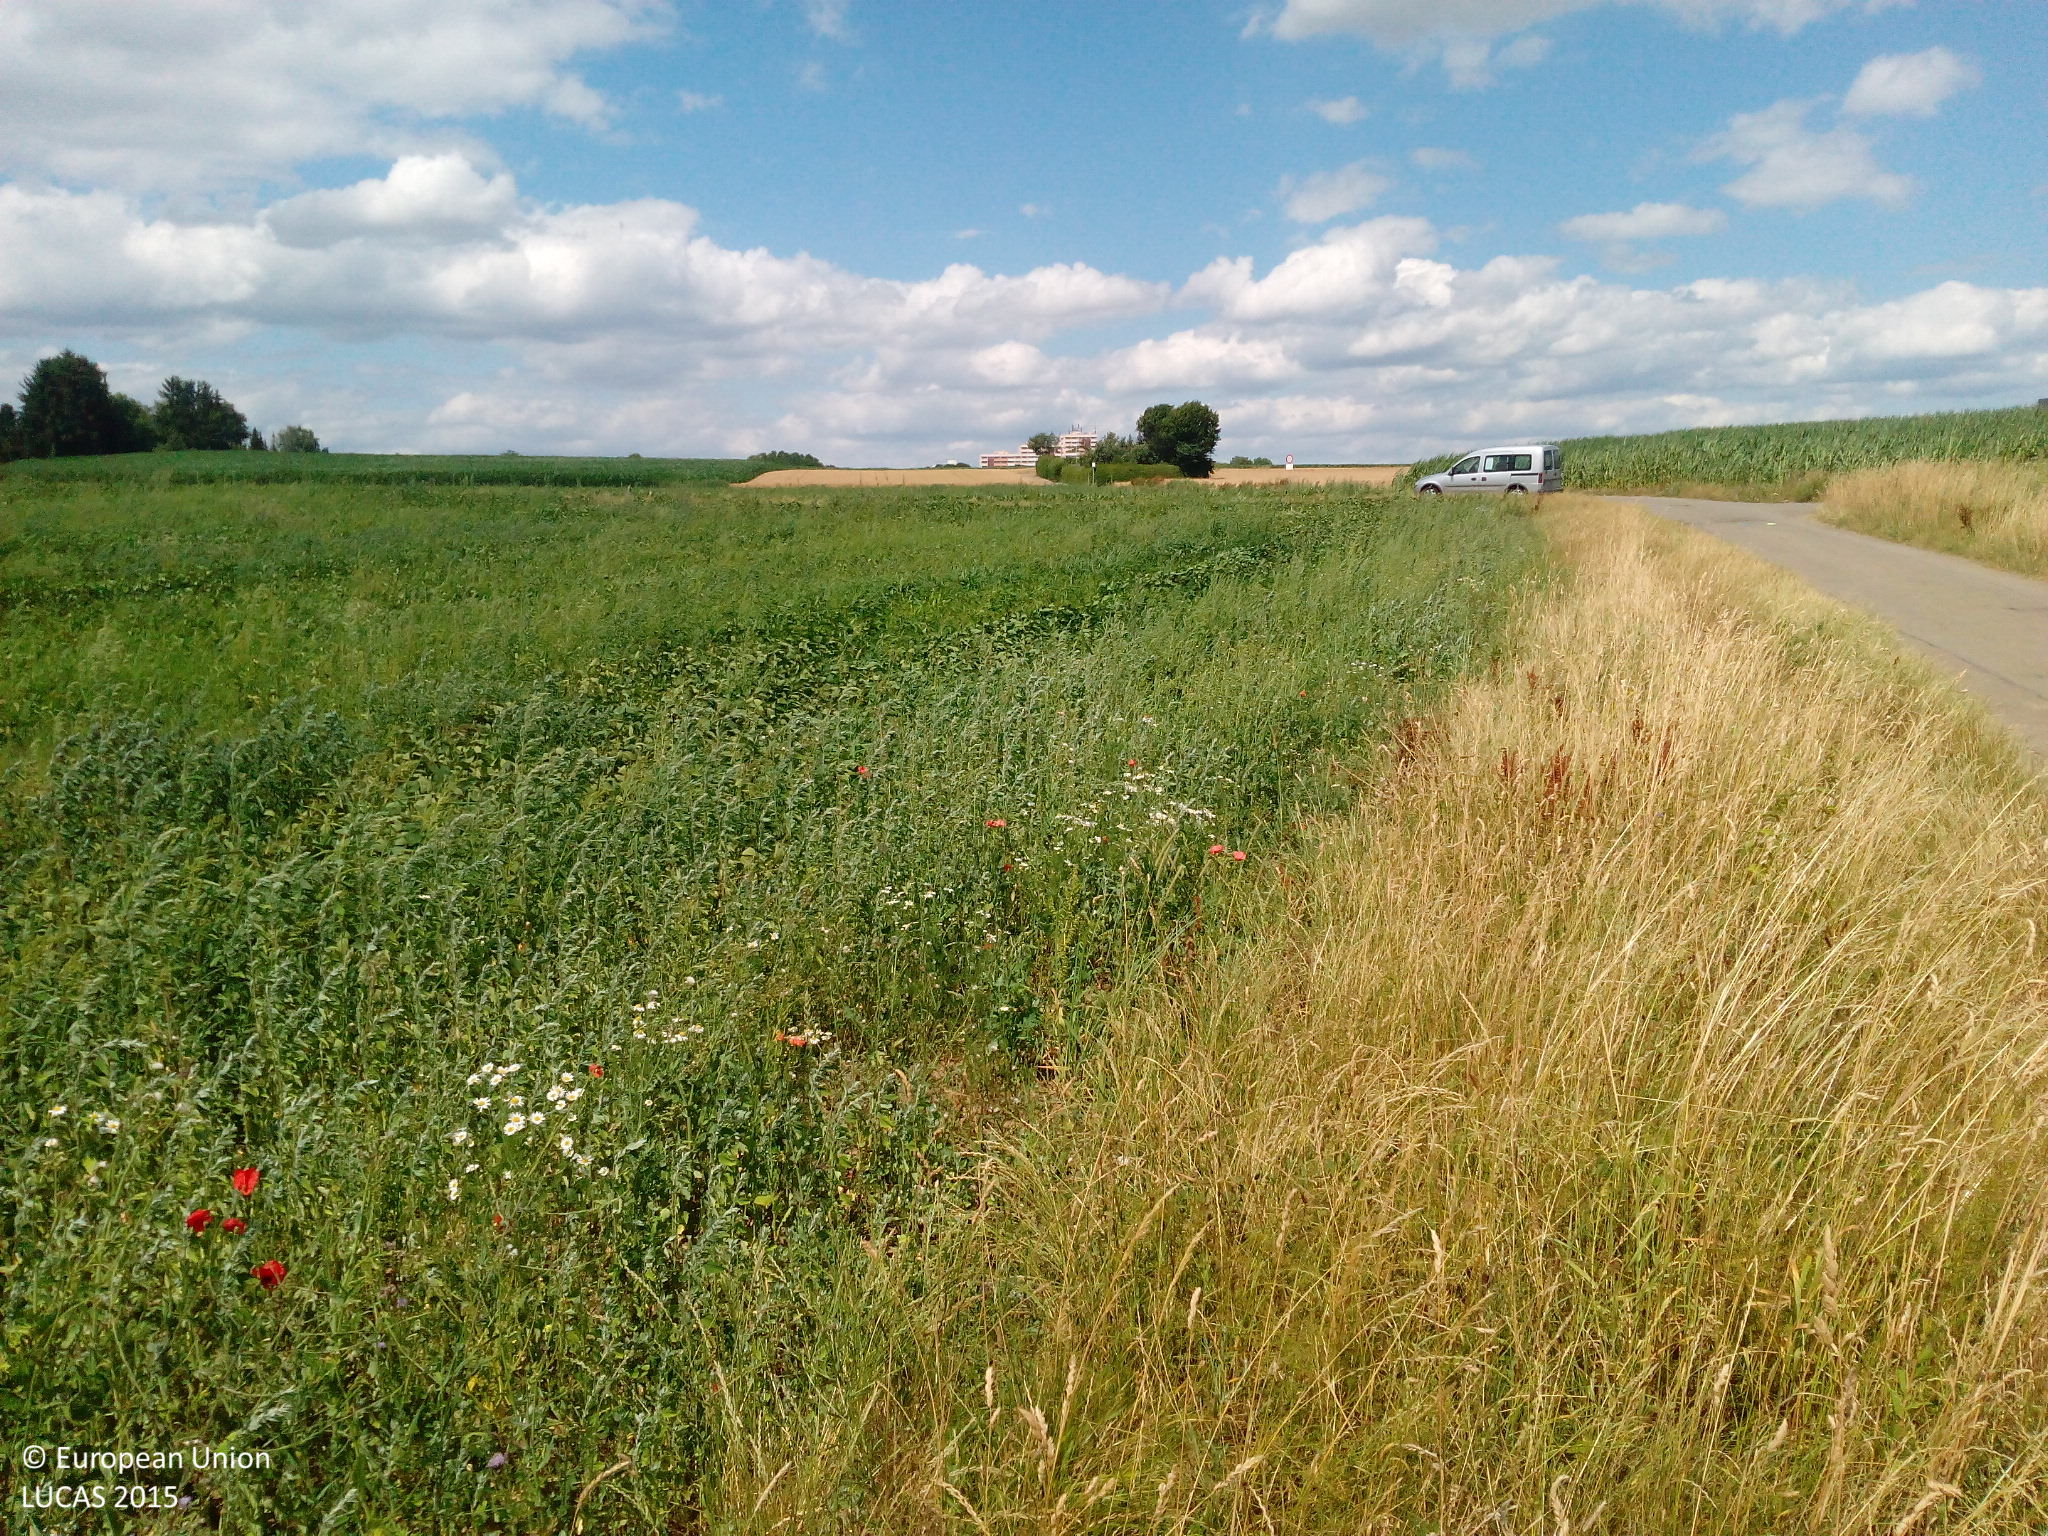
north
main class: Grassland
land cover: Spontaneously vegetated surfaces
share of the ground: > 75 %
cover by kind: herbaceous plants 85 %, unconsolidated bare surface 15 %
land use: Agriculture (excluding fallow land and kitchen gardens)
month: July
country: DE
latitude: 48.8504
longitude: 9.1963
